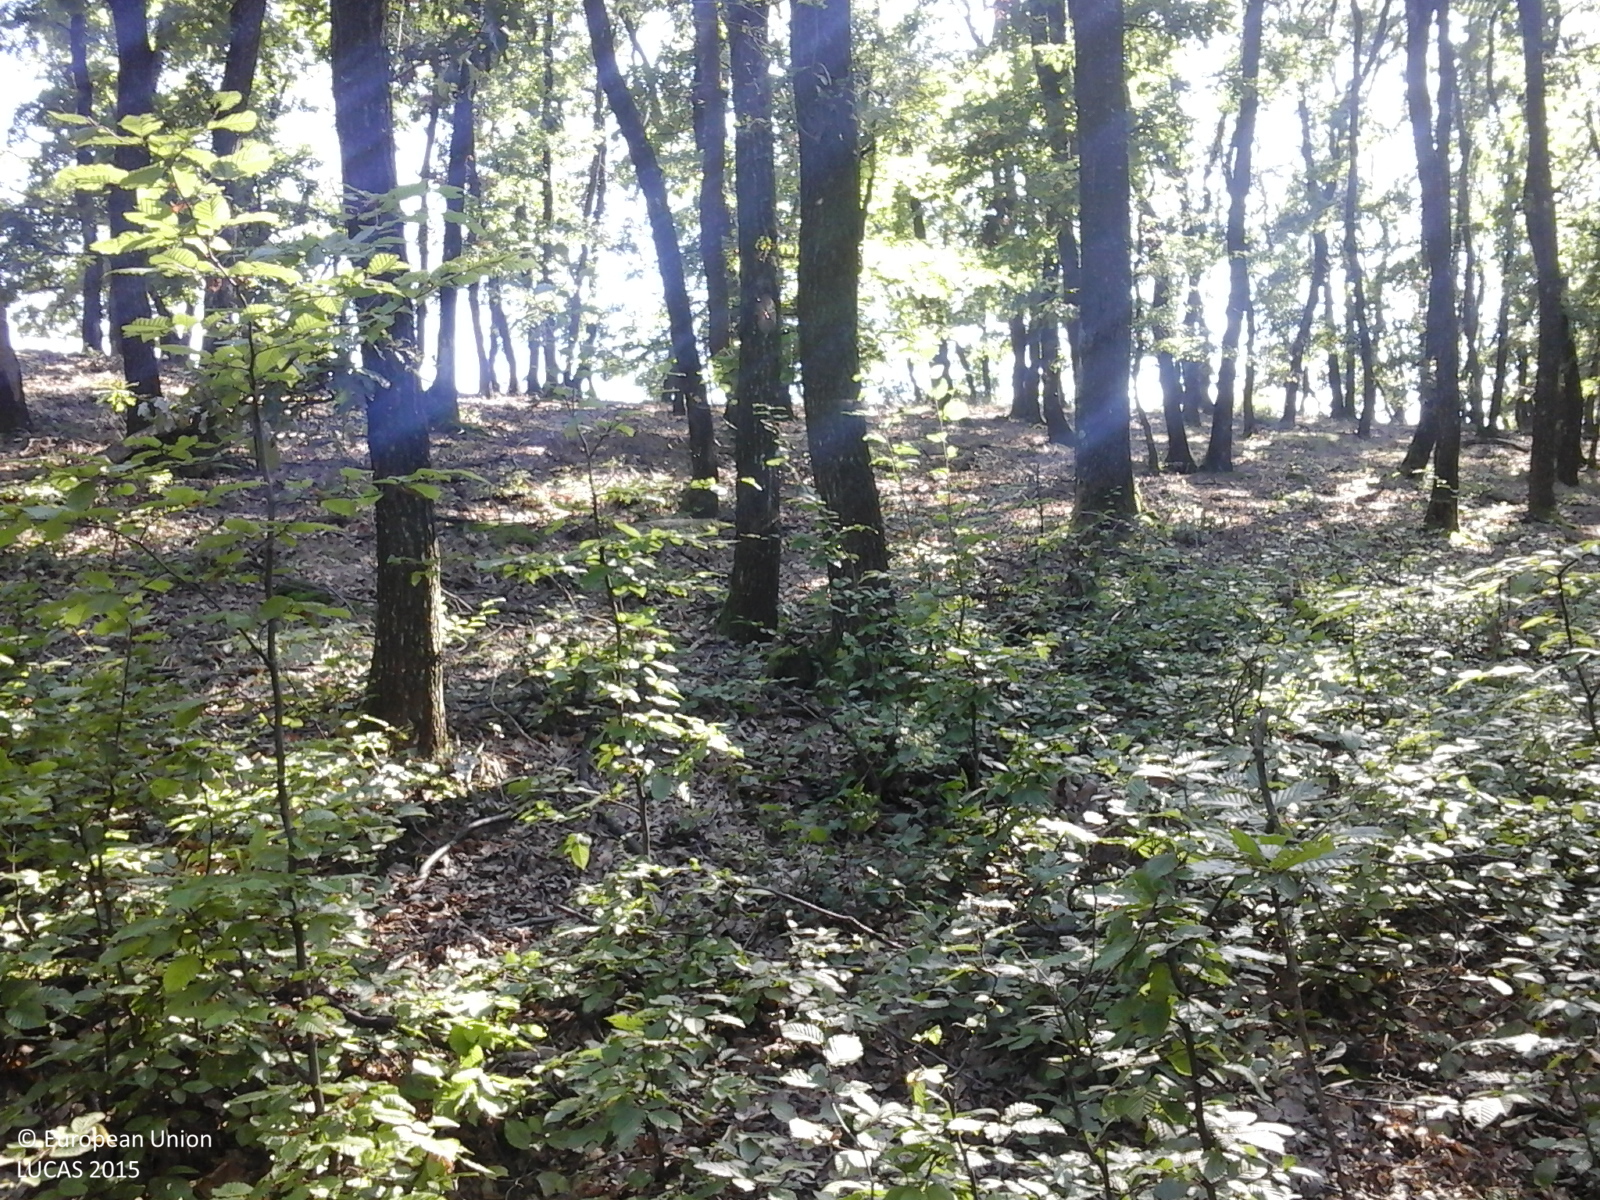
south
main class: Woodland
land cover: Broadleaved woodland
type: acidophilous oak and oak-birch forest
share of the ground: > 75 %
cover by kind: broadleaved forest trees 90 %, herbaceous plants 10 %
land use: Forestry
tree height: > 5 m
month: October
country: RO
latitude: 46.3069
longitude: 23.8227
